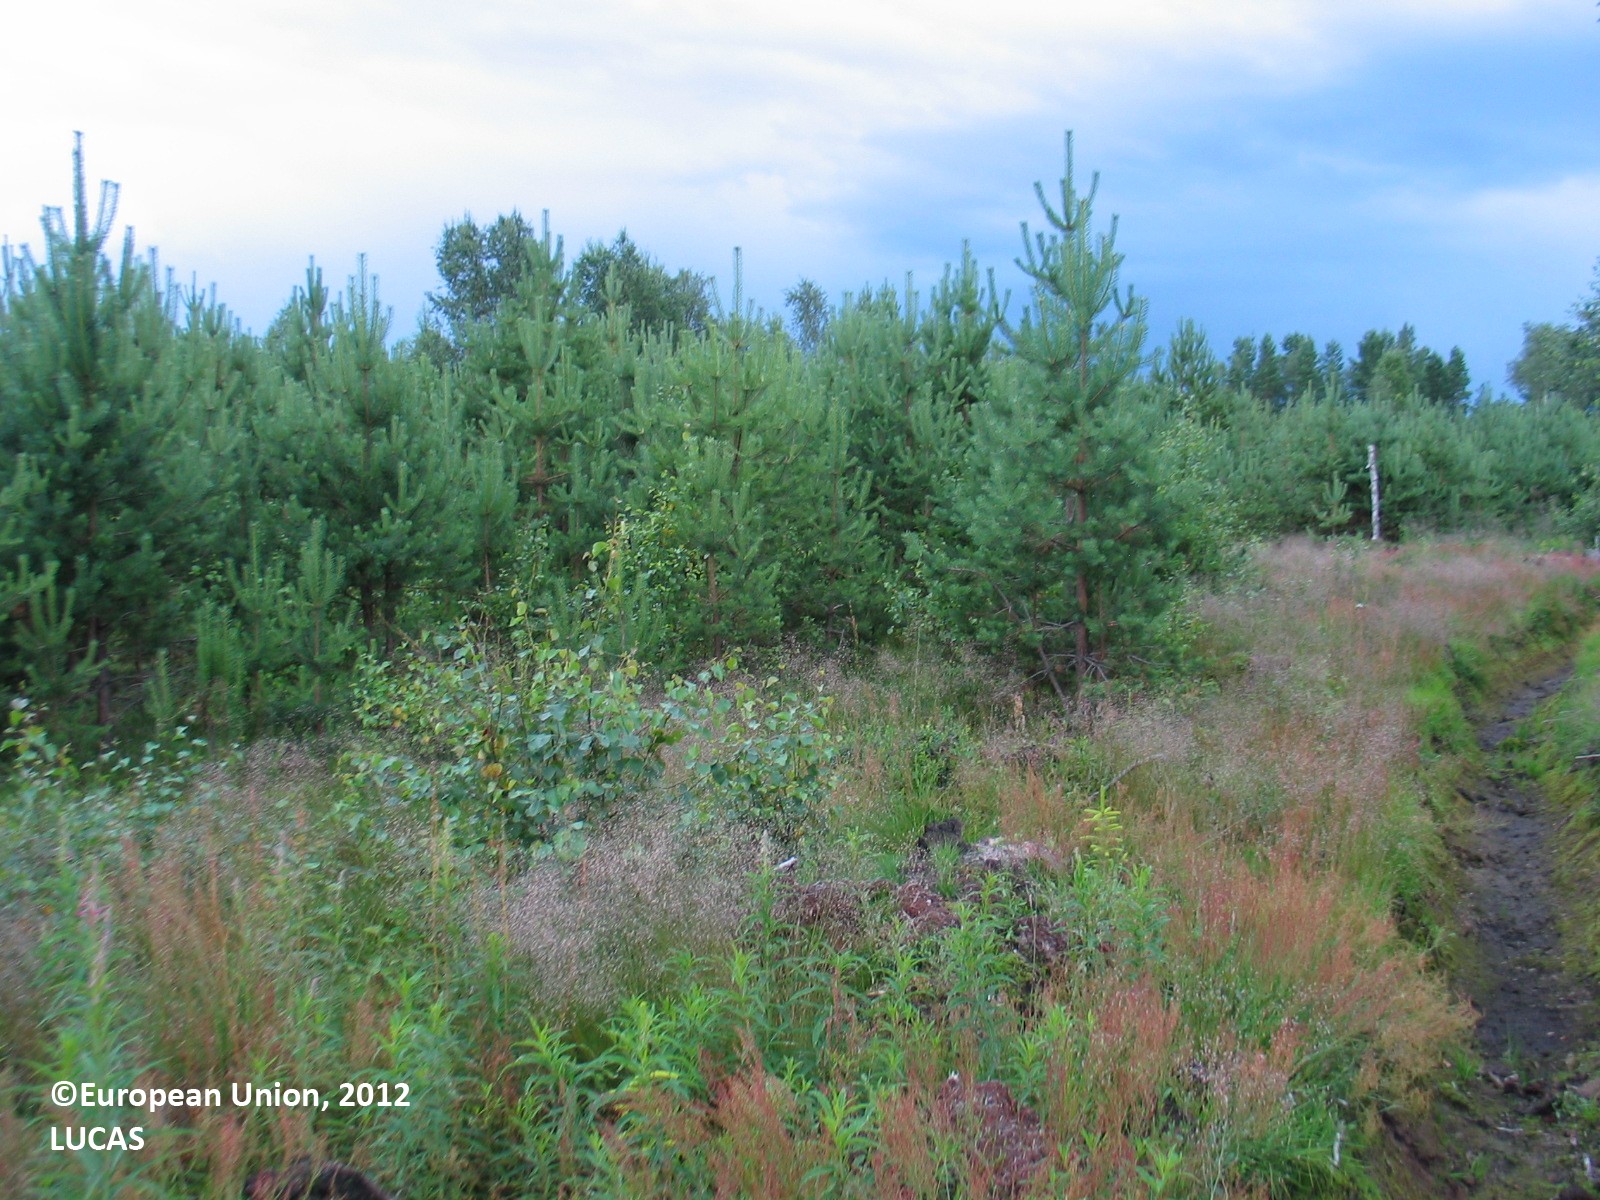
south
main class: Grassland
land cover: Grassland with sparse tree/shrub cover
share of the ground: > 75 %
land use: Forestry
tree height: < 5 m
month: July
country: FI
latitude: 64.5595
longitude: 26.3631
